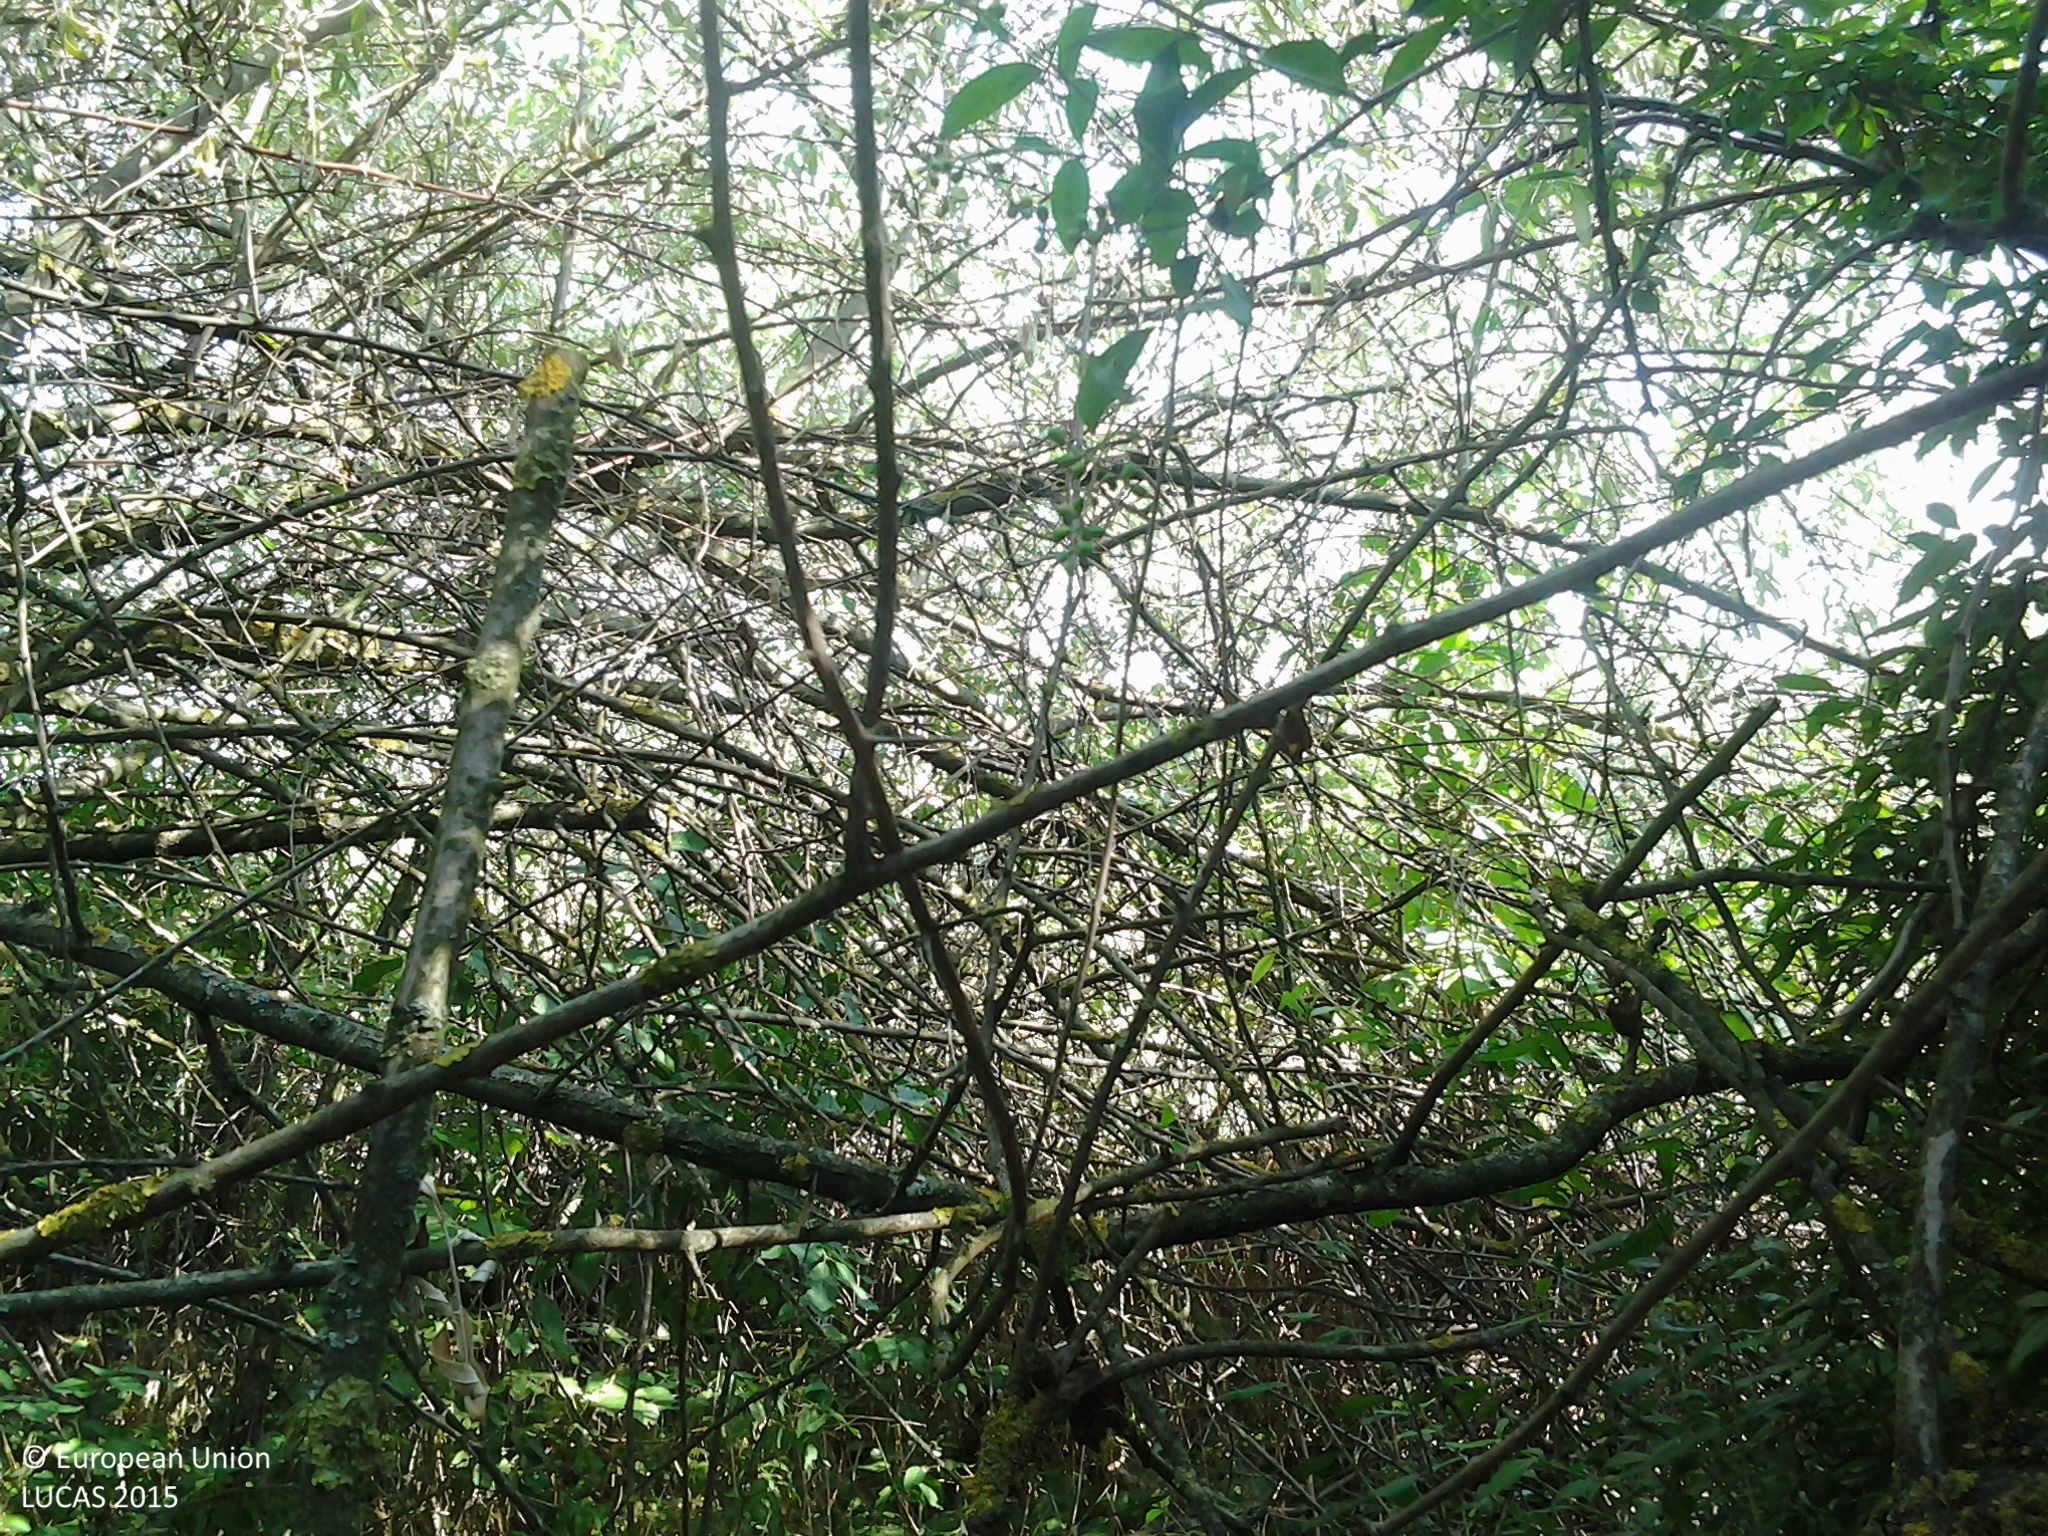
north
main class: Woodland
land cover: Broadleaved woodland
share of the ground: 50 - 75 %
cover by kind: broadleaved forest trees 60 %, herbaceous plants 40 %
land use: Semi-natural and natural areas not in use
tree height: > 5 m
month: July
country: HU
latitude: 46.8032
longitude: 19.2281
